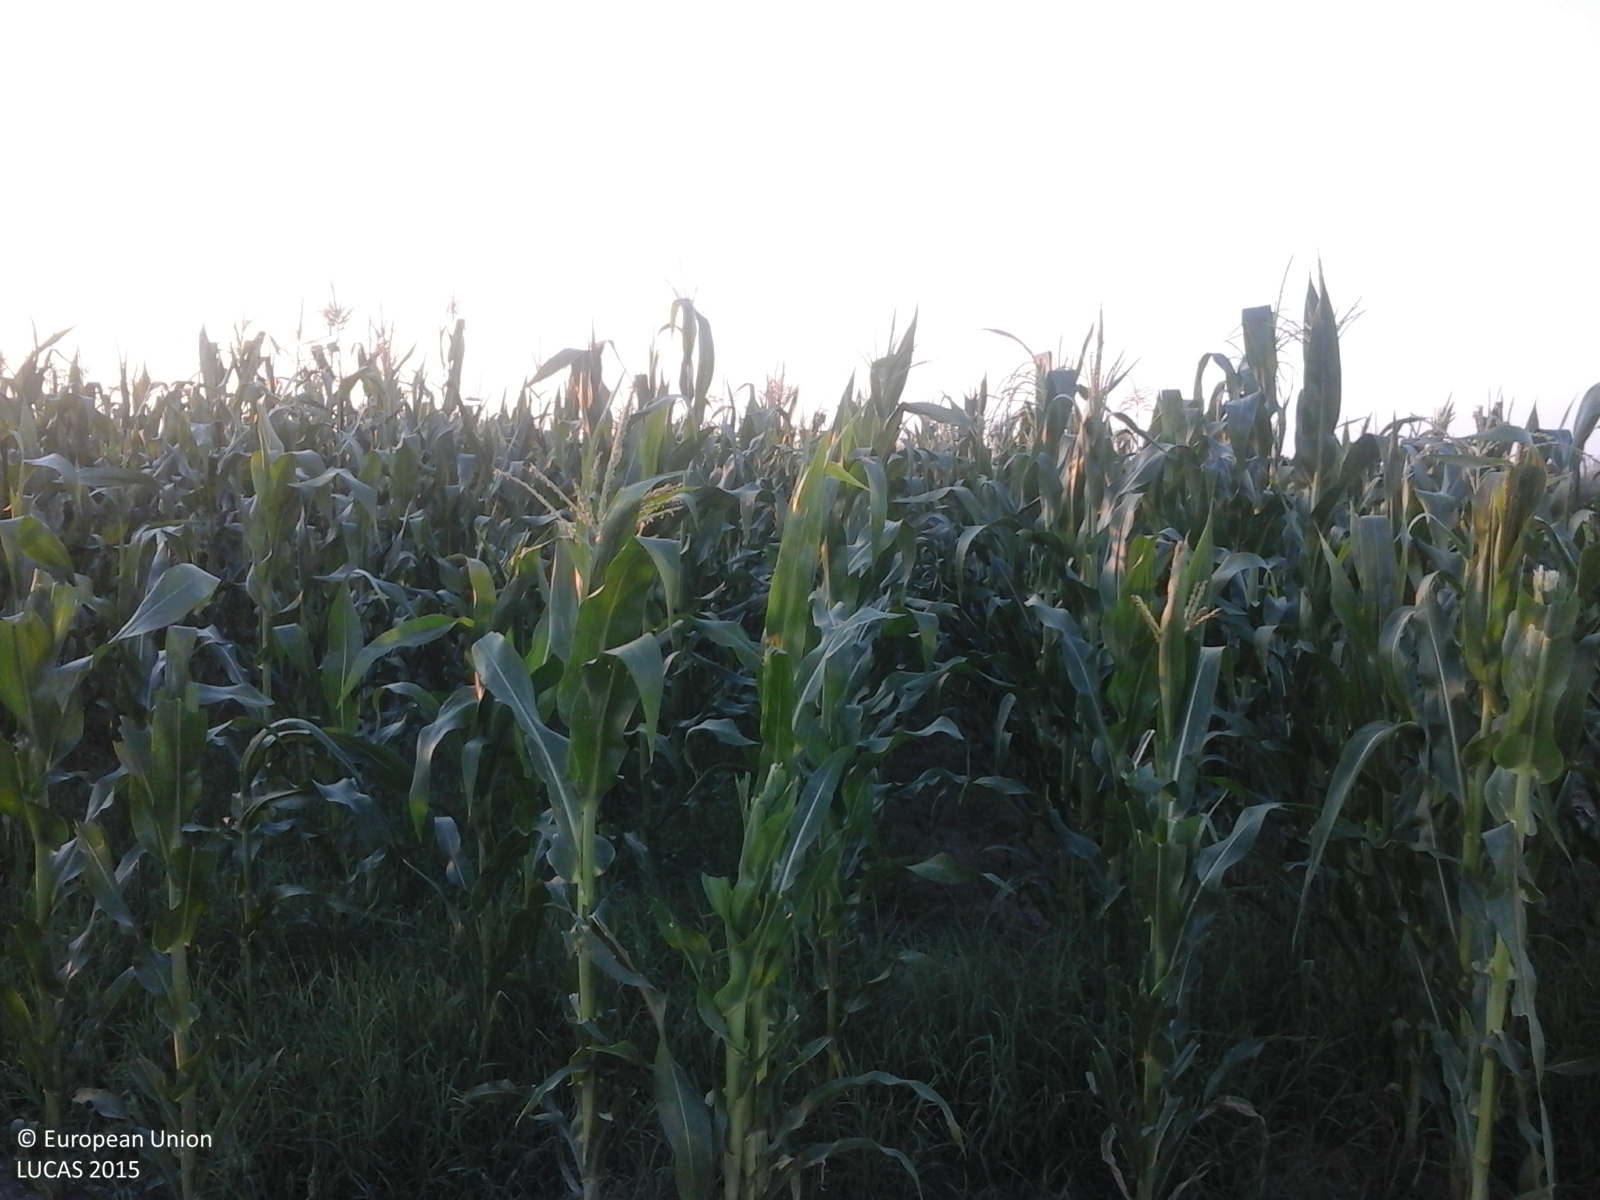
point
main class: Cropland
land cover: Maize
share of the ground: > 75 %
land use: Agriculture (excluding fallow land and kitchen gardens)
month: July
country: RO
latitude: 44.3628
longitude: 24.2822
